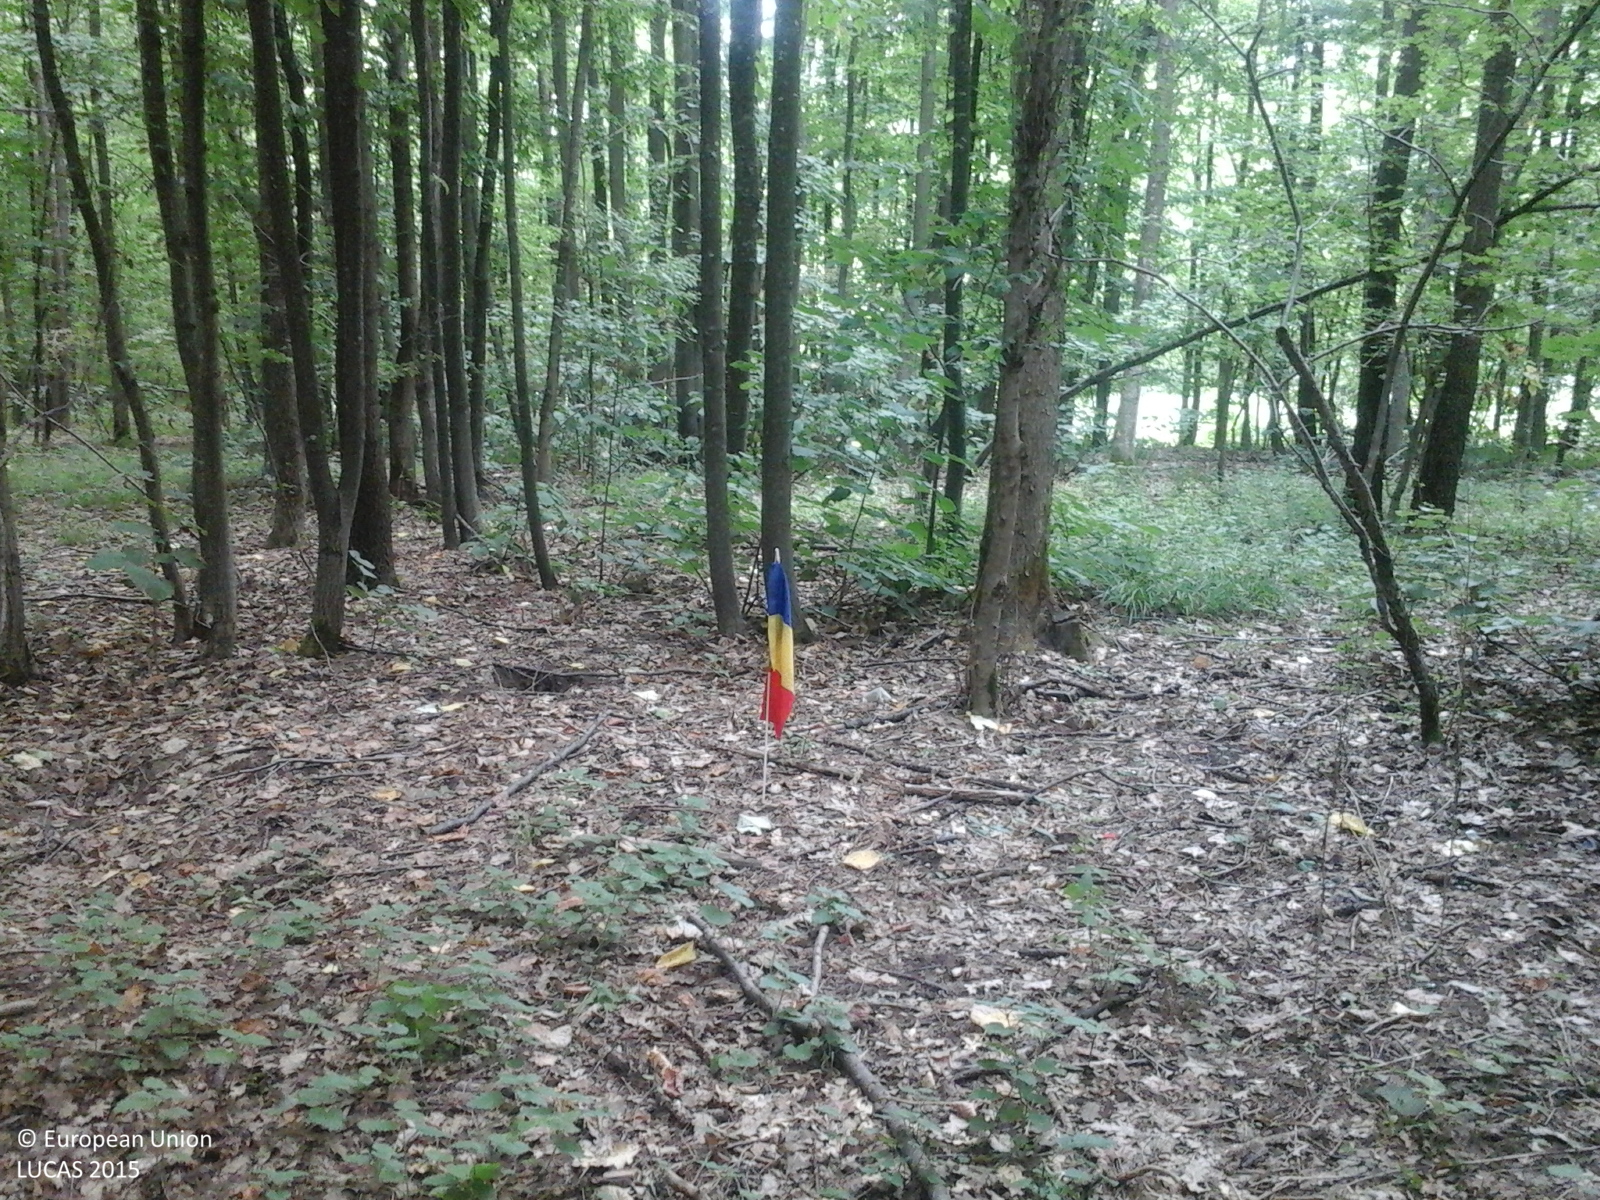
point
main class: Woodland
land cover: Broadleaved woodland
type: mesophytic deciduous forest
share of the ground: > 75 %
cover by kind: broadleaved forest trees 100 %
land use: Forestry
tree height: > 5 m
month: July
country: RO
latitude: 44.4756
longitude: 25.6461
